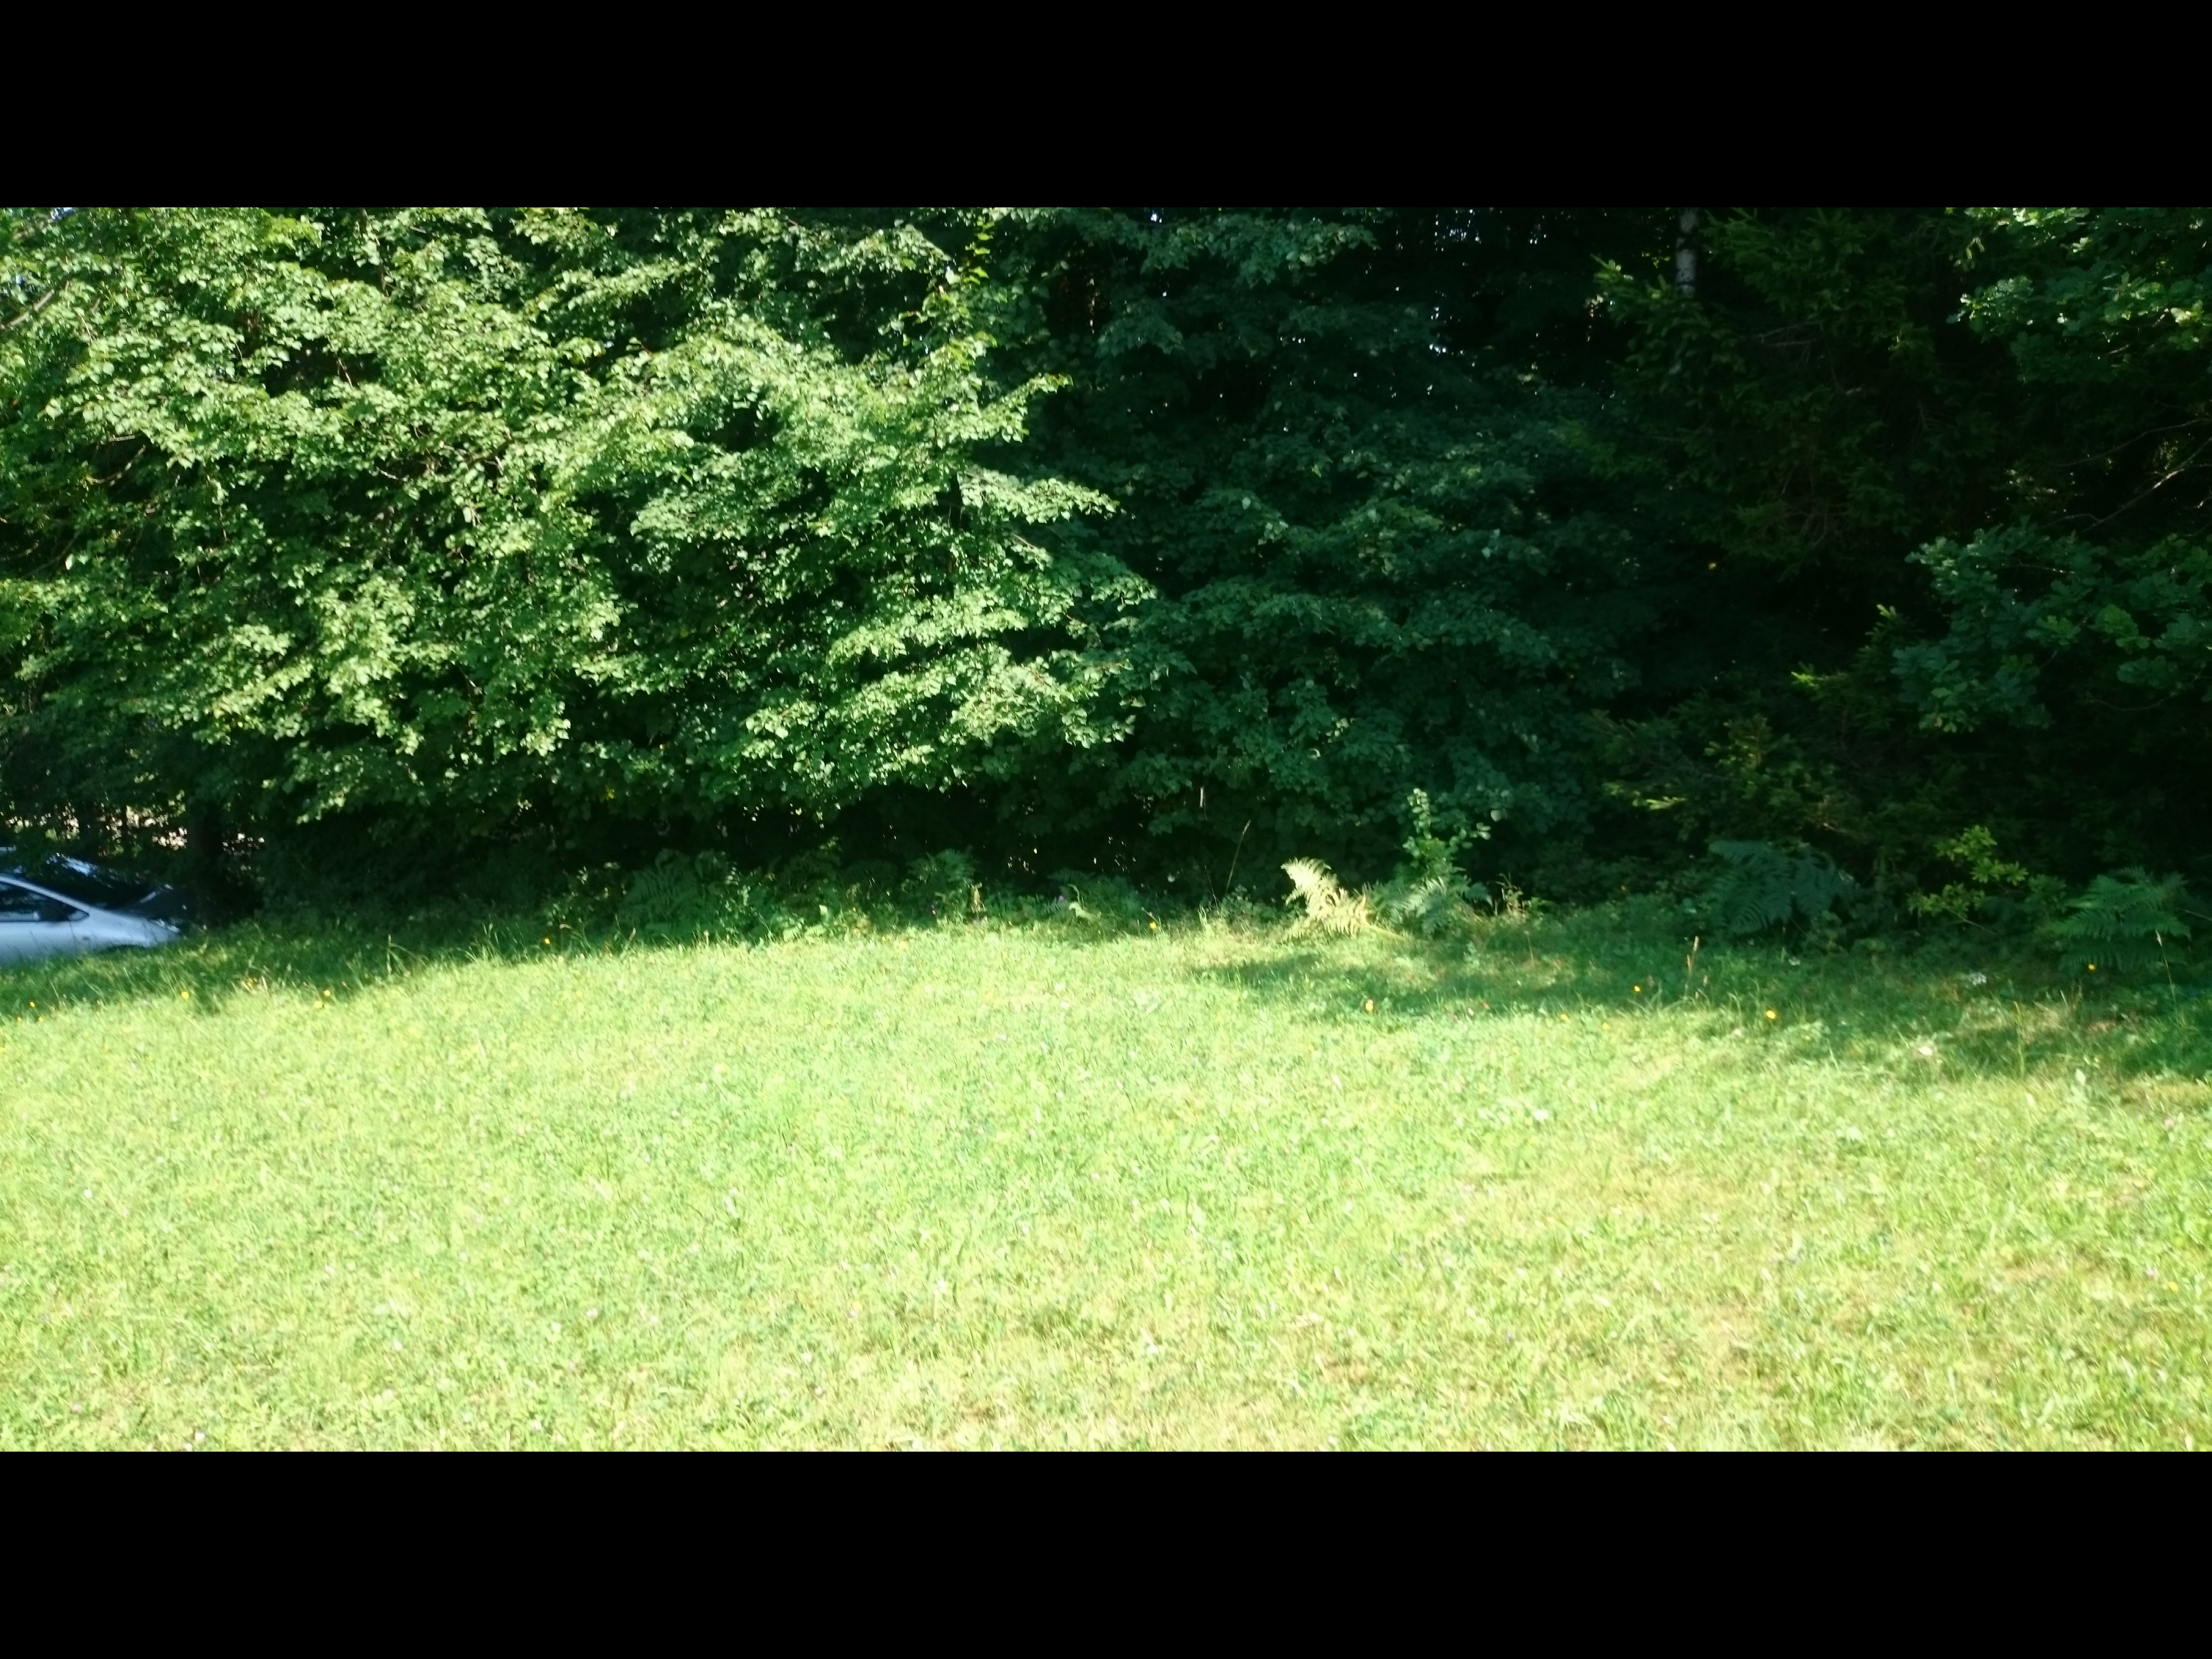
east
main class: Grassland
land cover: Grassland without tree/shrub cover
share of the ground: > 75 %
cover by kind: herbaceous plants 95 %, unconsolidated bare surface 5 %
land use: Agriculture (excluding fallow land and kitchen gardens)
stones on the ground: < 10 %
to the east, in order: Grassland without tree/shrub cover; Broadleaved woodland; Other mixed woodland; Tracks; Other mixed woodland; Grassland without tree/shrub cover; Fences; Grassland without tree/shrub cover; Apple fruit; Grassland without tree/shrub cover; Fences; Other mixed woodland
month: July
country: AT
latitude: 47.1967
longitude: 15.6103
